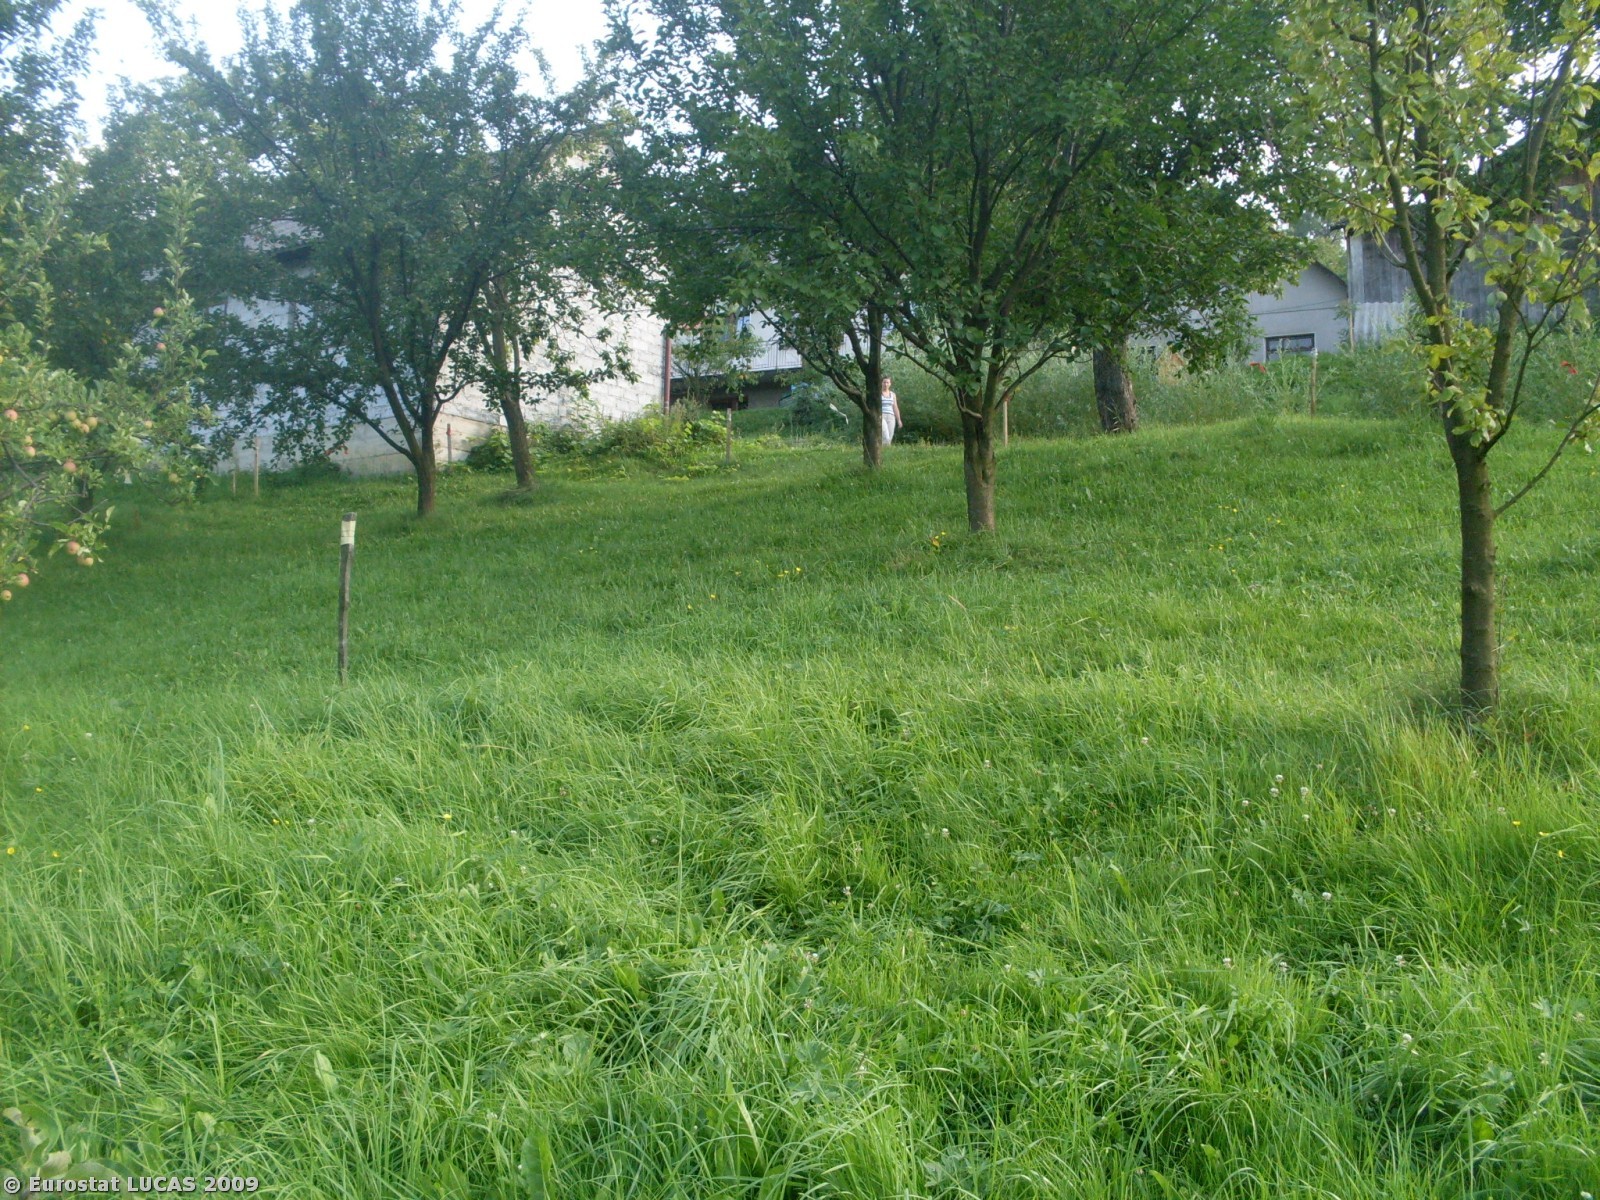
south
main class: Cropland
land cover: Apple fruit
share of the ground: 50 - 75 %
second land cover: Grassland with sparse tree/shrub cover
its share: > 75 %
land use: Agriculture (excluding fallow land and kitchen gardens)
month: July
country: PL
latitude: 49.7890
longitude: 20.4966
